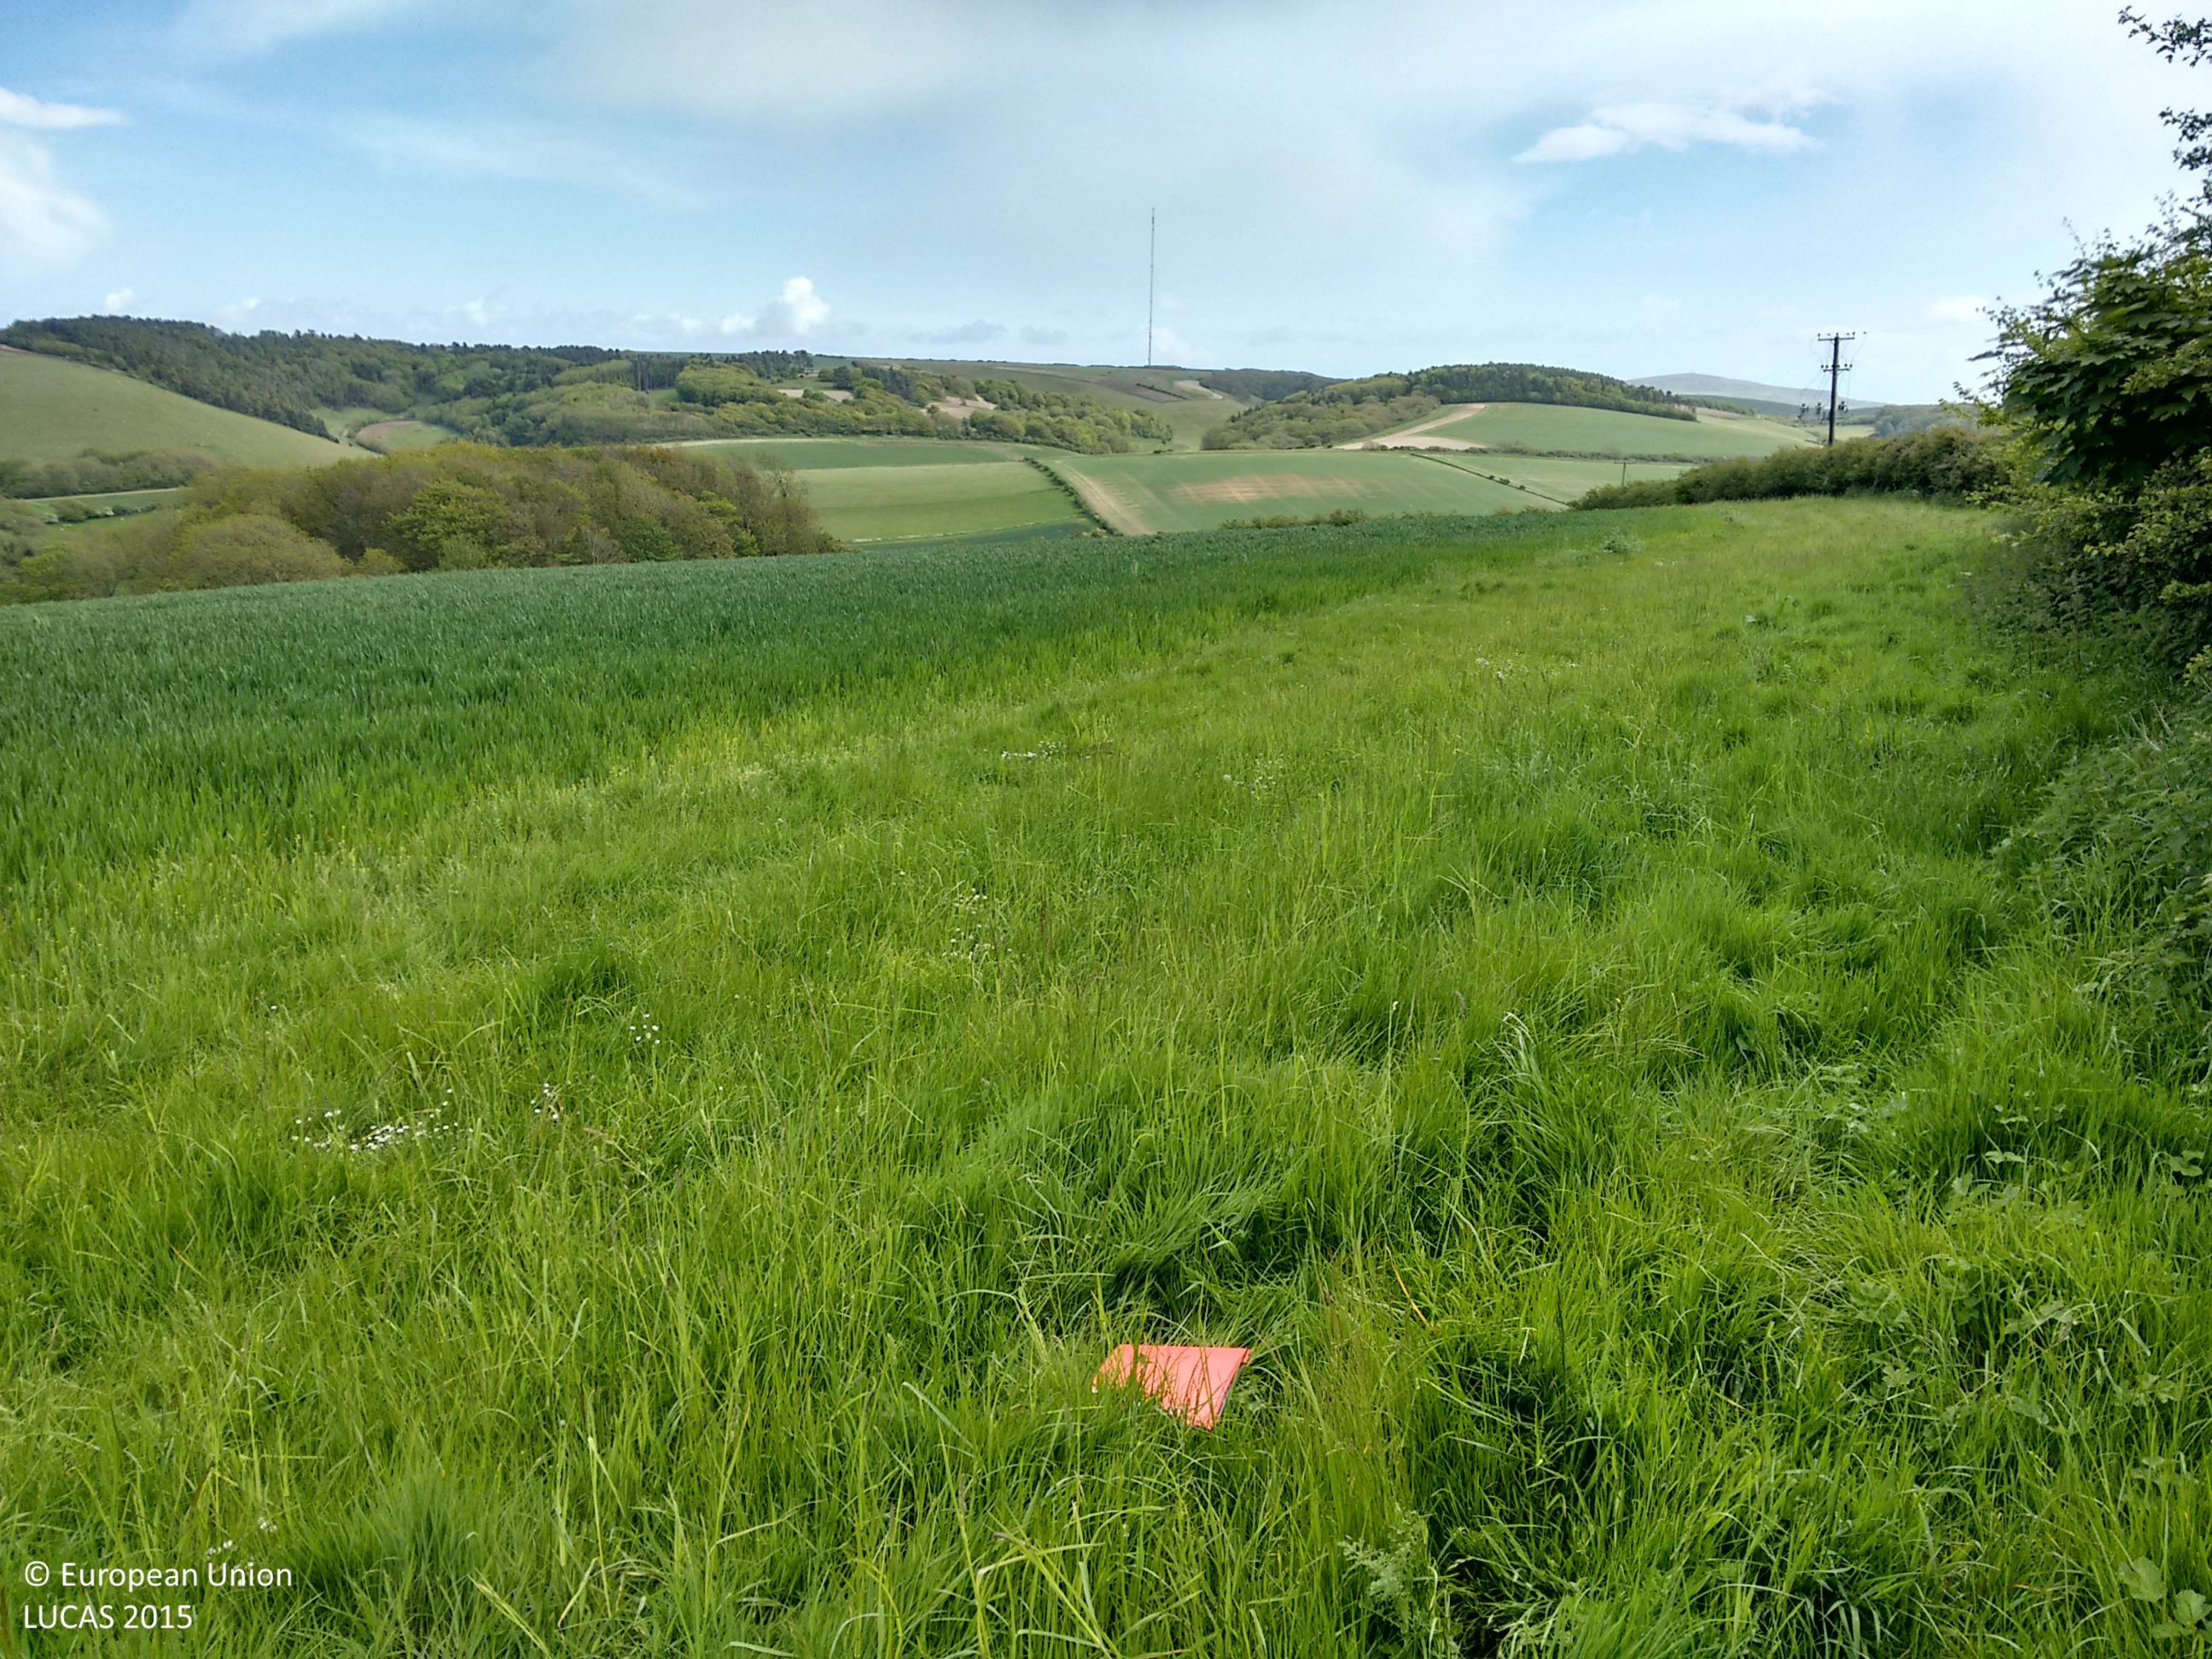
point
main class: Grassland
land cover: Grassland without tree/shrub cover
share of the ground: > 75 %
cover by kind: herbaceous plants 100 %
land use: Agriculture (excluding fallow land and kitchen gardens)
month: May
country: GB
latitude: 50.6684
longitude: -1.3537
